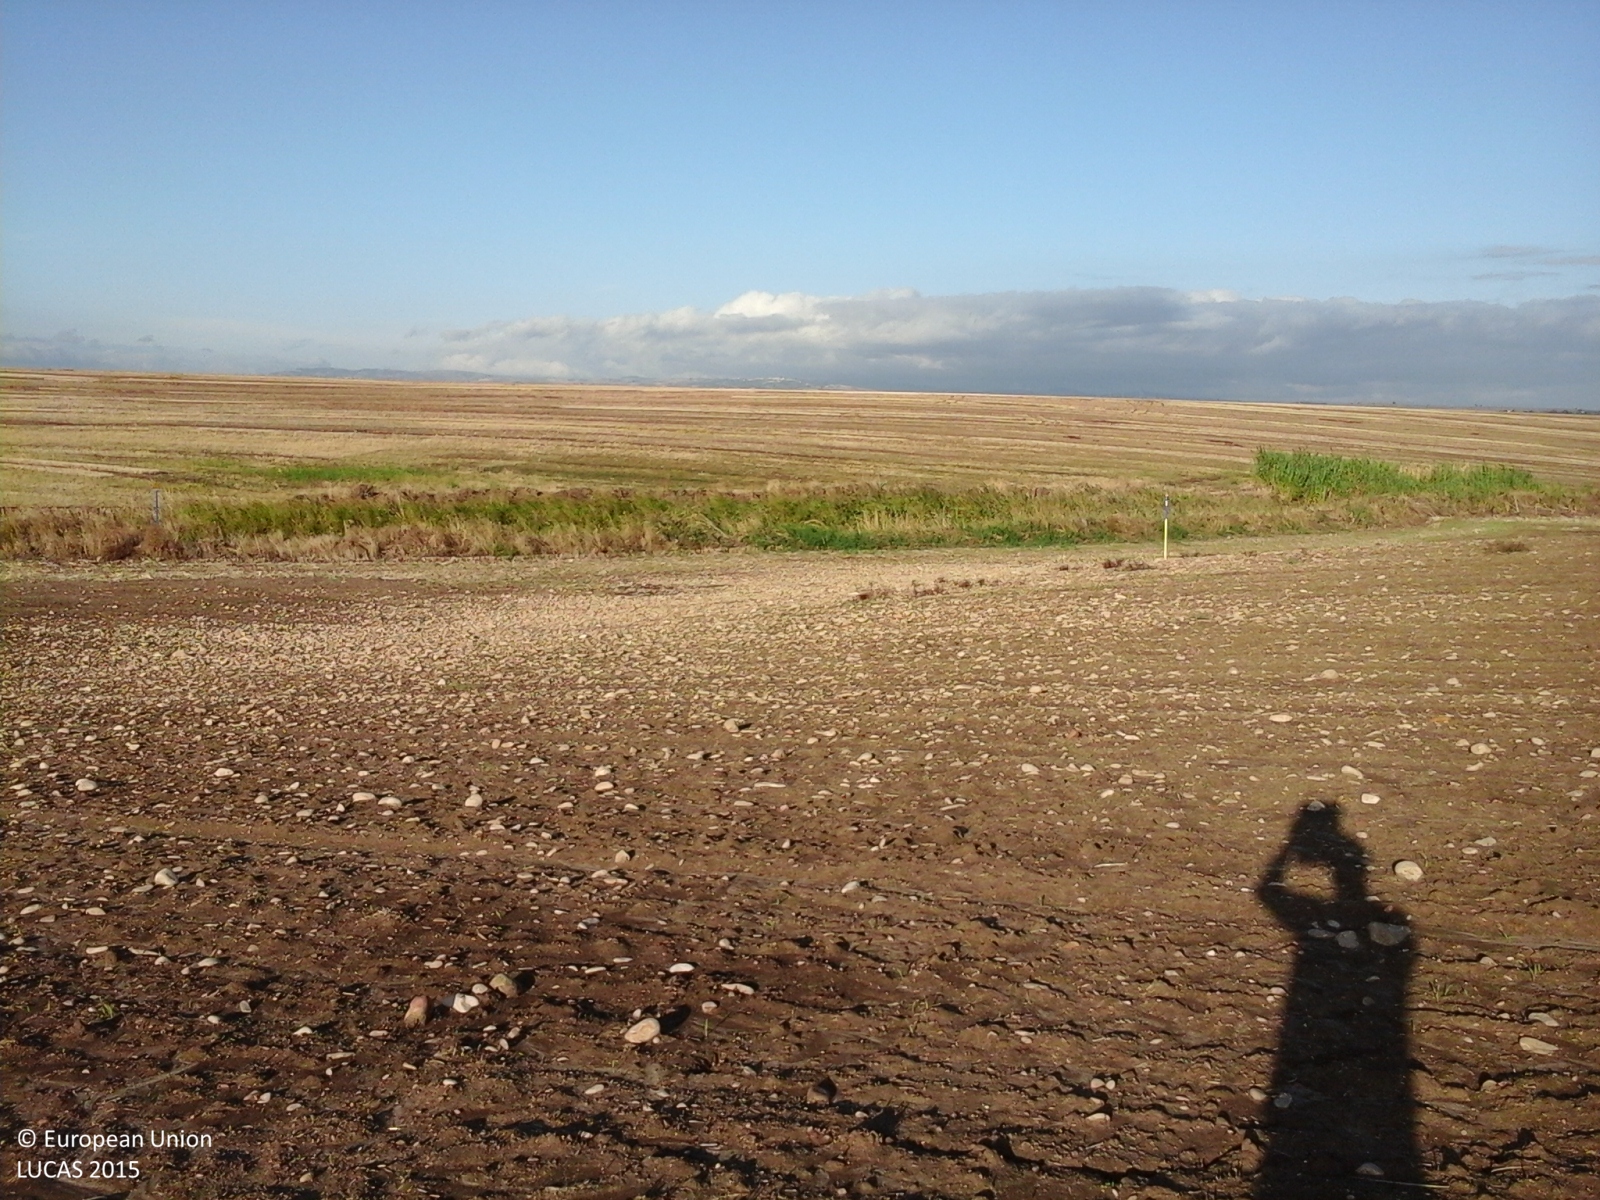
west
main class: Cropland
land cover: Durum wheat
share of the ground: > 75 %
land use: Agriculture (excluding fallow land and kitchen gardens)
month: September
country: IT
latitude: 41.7234
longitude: 15.2125
